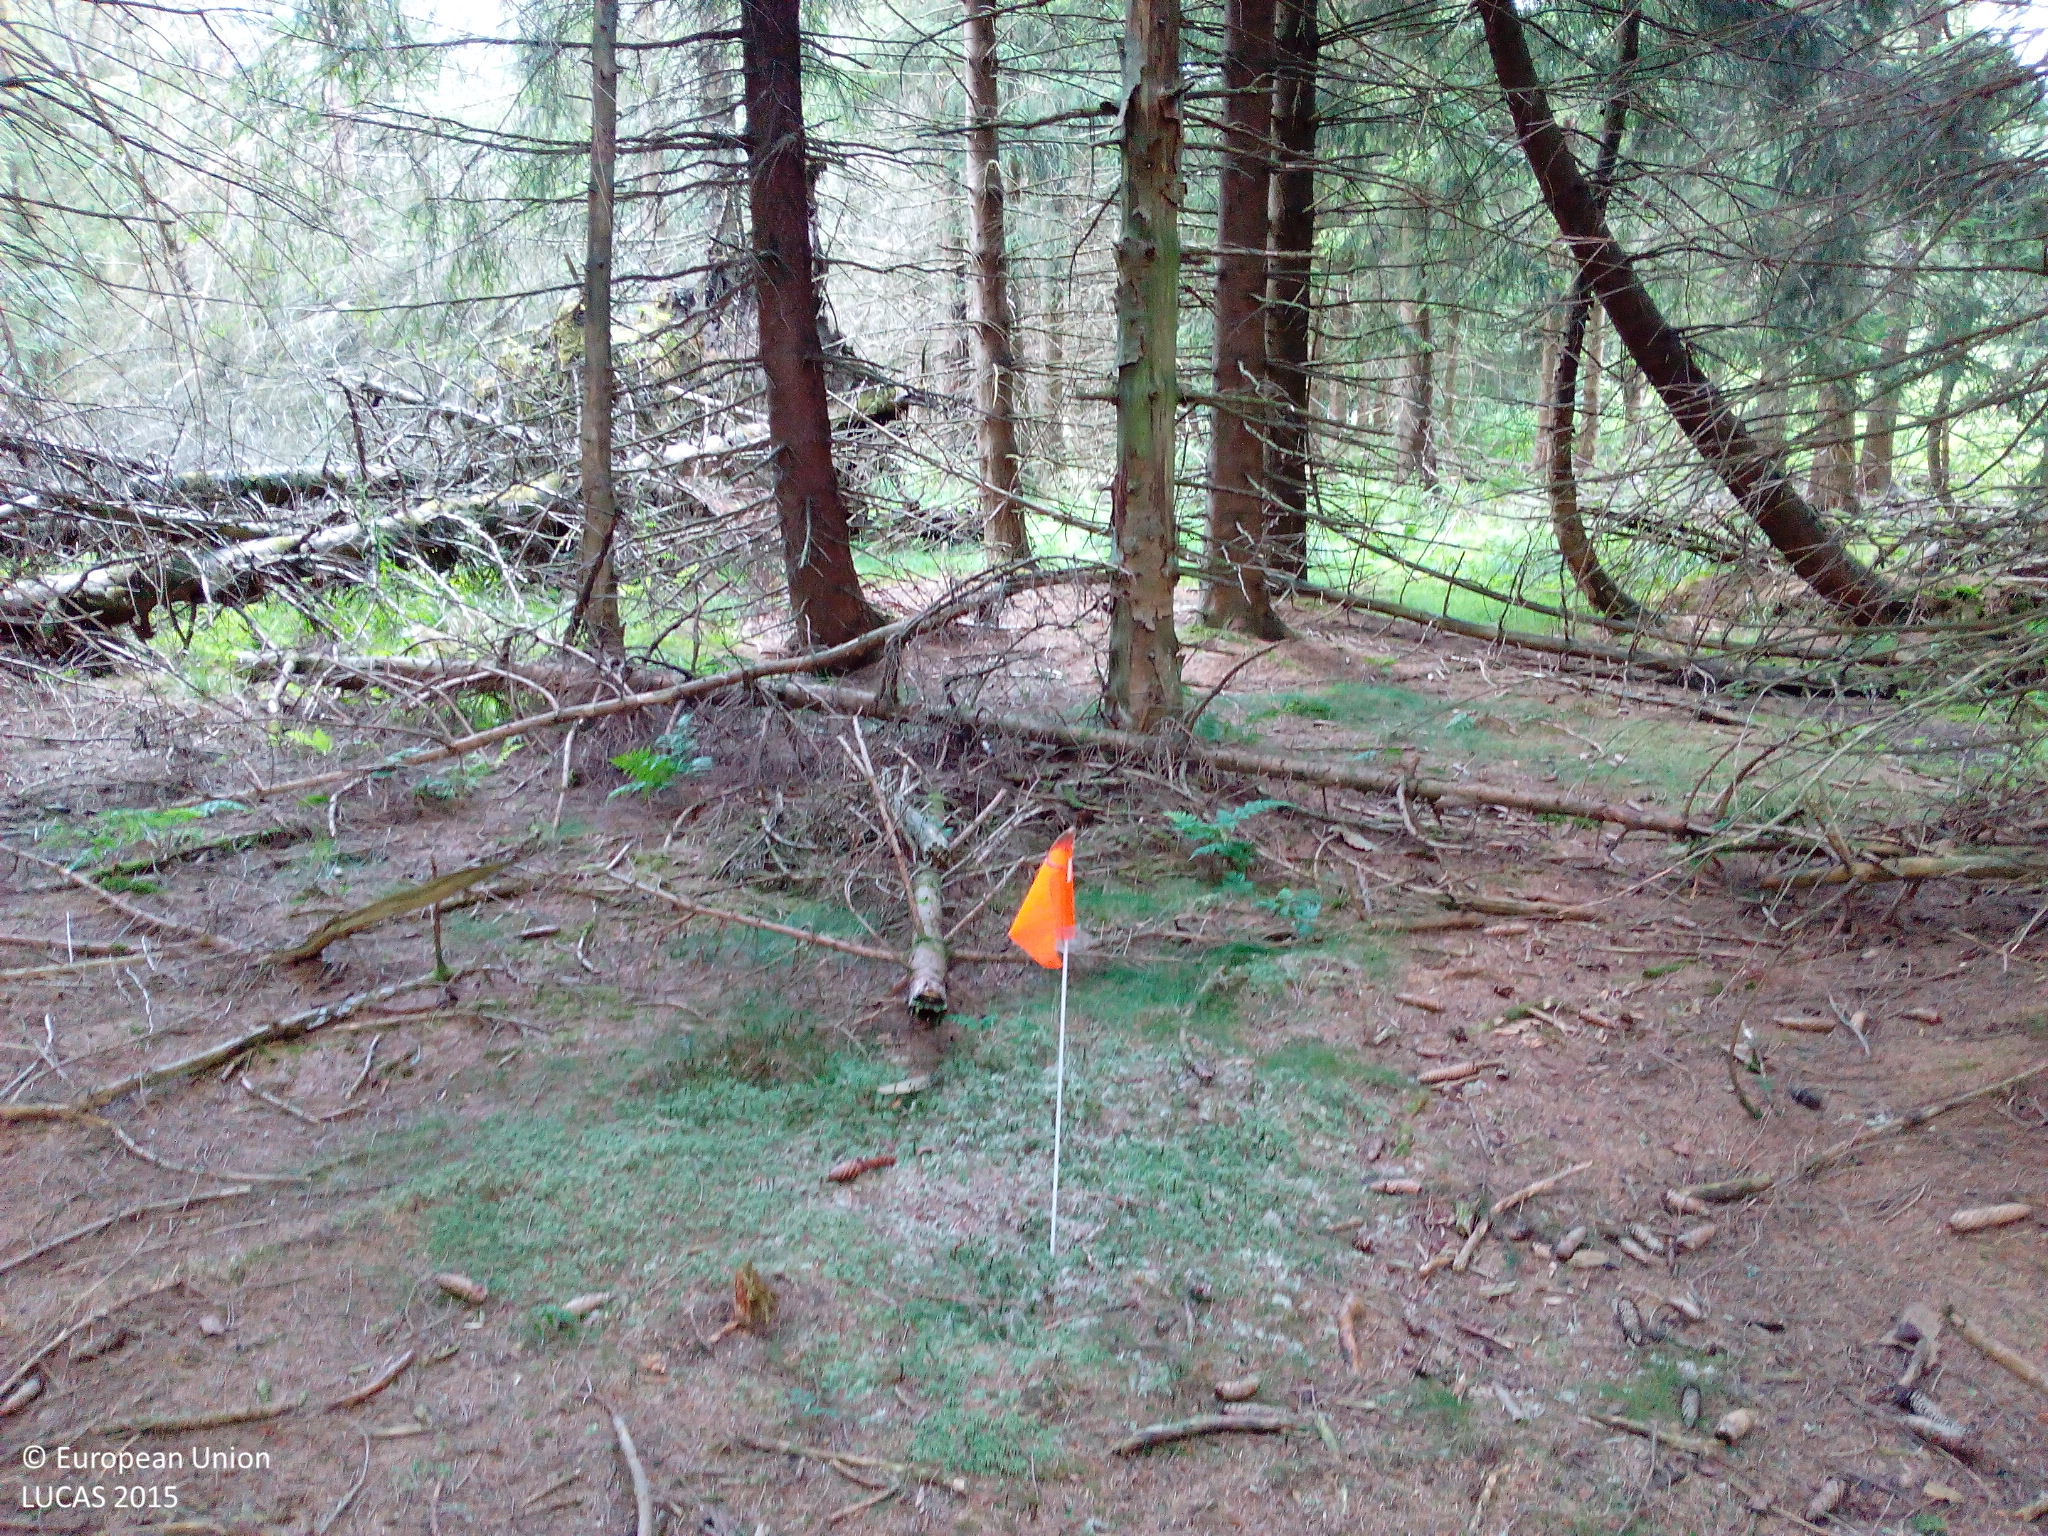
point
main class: Woodland
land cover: Spruce dominated coniferous woodland
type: hemiboreal forest and nemoral coniferous forest and mixed broadleaved-coniferous forest
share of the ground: > 75 %
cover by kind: coniferous forest trees 95 %, herbaceous plants 5 %
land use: Forestry
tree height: > 5 m
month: July
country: DE
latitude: 50.4899
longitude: 9.9577
